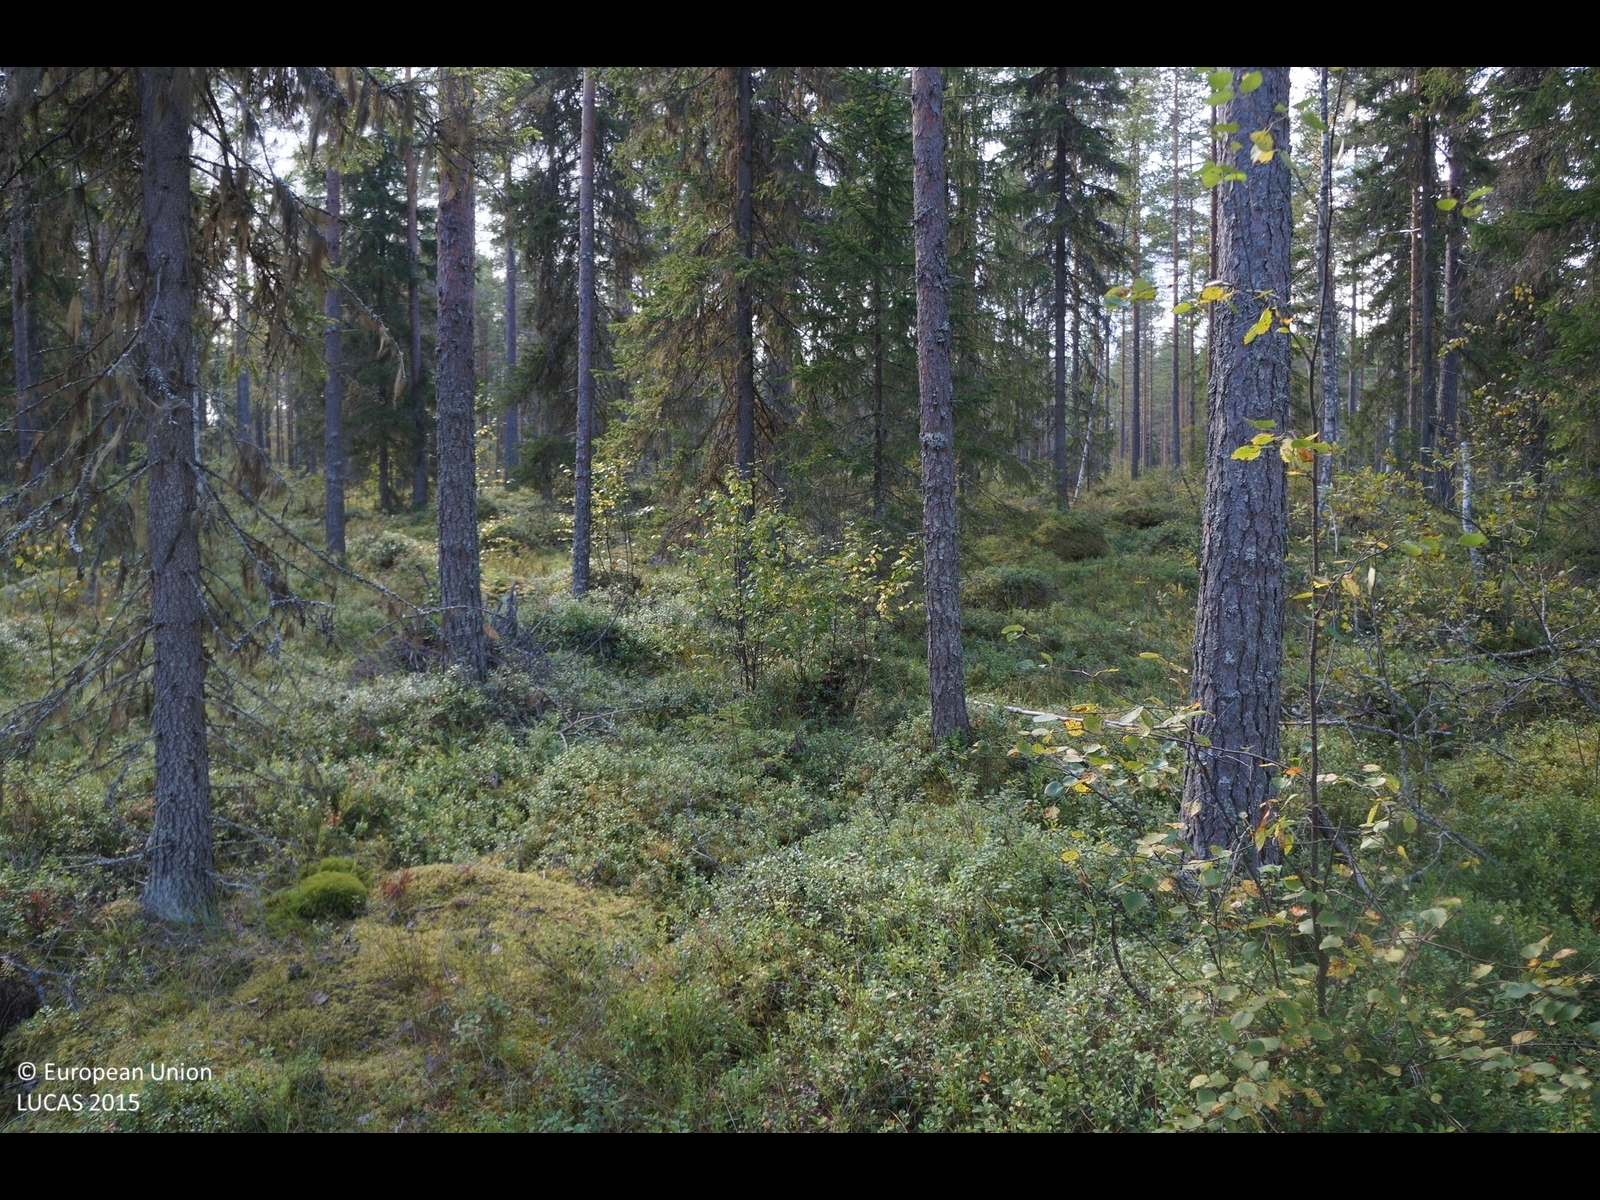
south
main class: Woodland
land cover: Pine dominated coniferous woodland
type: boreal forest
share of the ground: 25 - 50 %
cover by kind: coniferous forest trees 40 %, shrubs 40 %, herbaceous plants 5 %, lichens and mosses 5 %, consolidated bare surface 5 %, unconsolidated bare surface 5 %
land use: Forestry
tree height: > 5 m
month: September
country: FI
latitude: 63.9555
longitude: 24.4243
